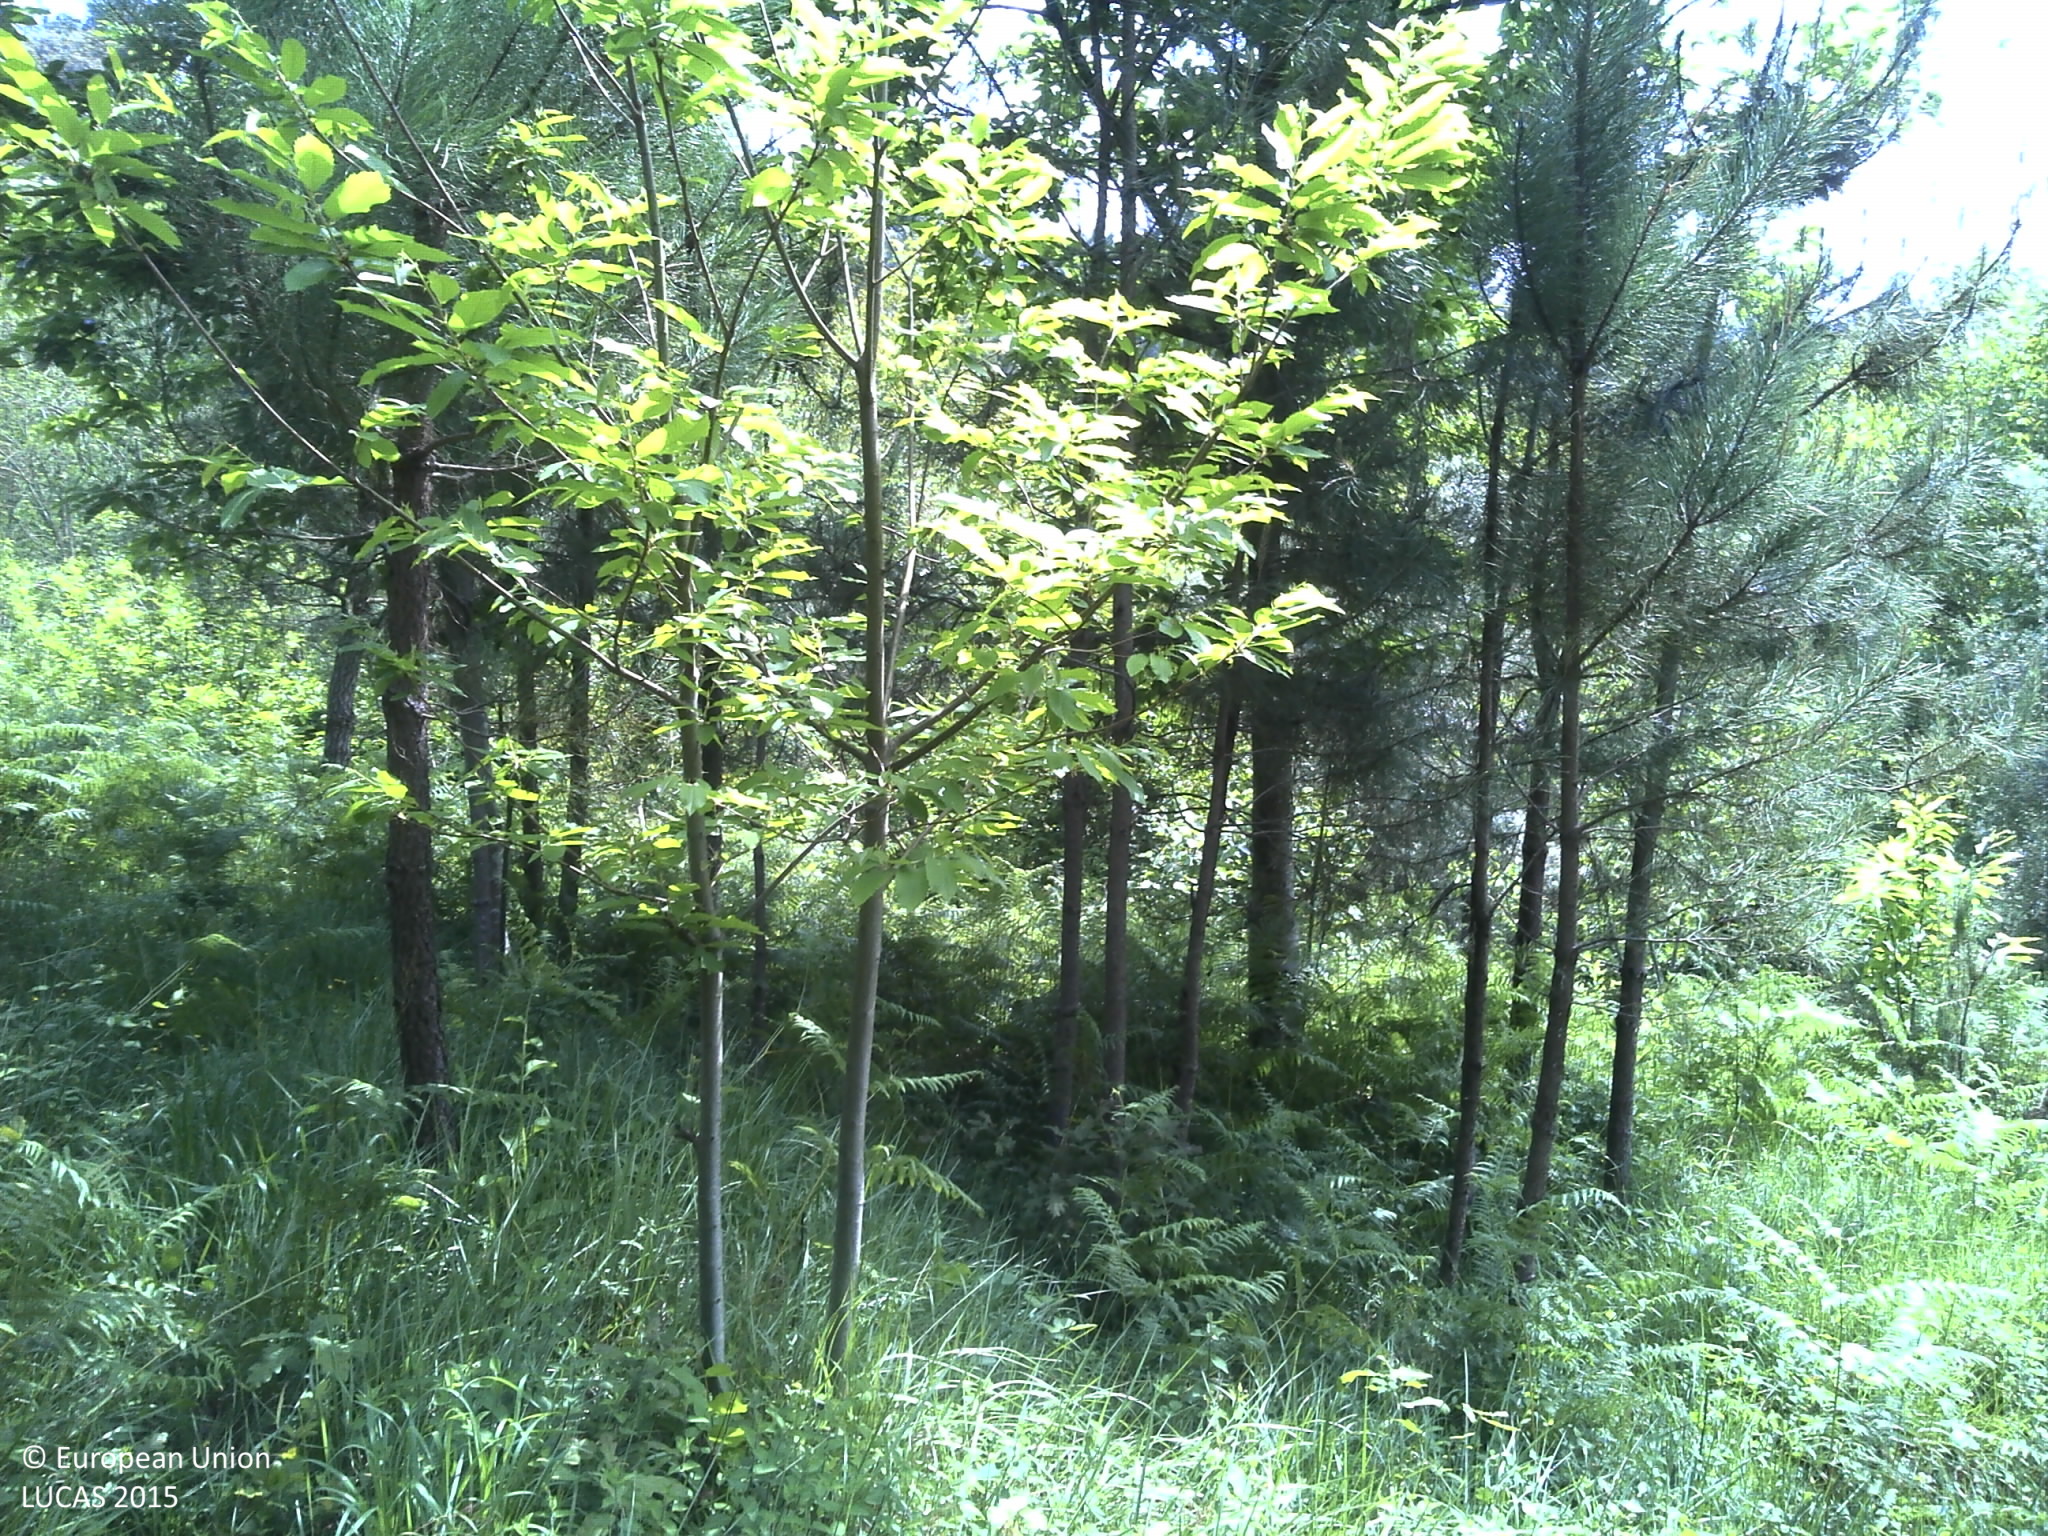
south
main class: Woodland
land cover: Pine dominated mixed woodland
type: coniferous forest of the mediterranean region
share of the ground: 50 - 75 %
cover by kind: coniferous forest trees 55 %, broadleaved forest trees 25 %, shrubs 10 %, herbaceous plants 5 %, unconsolidated bare surface 5 %
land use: Forestry
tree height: > 5 m
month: May
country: PT
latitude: 40.9681
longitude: -8.4073
